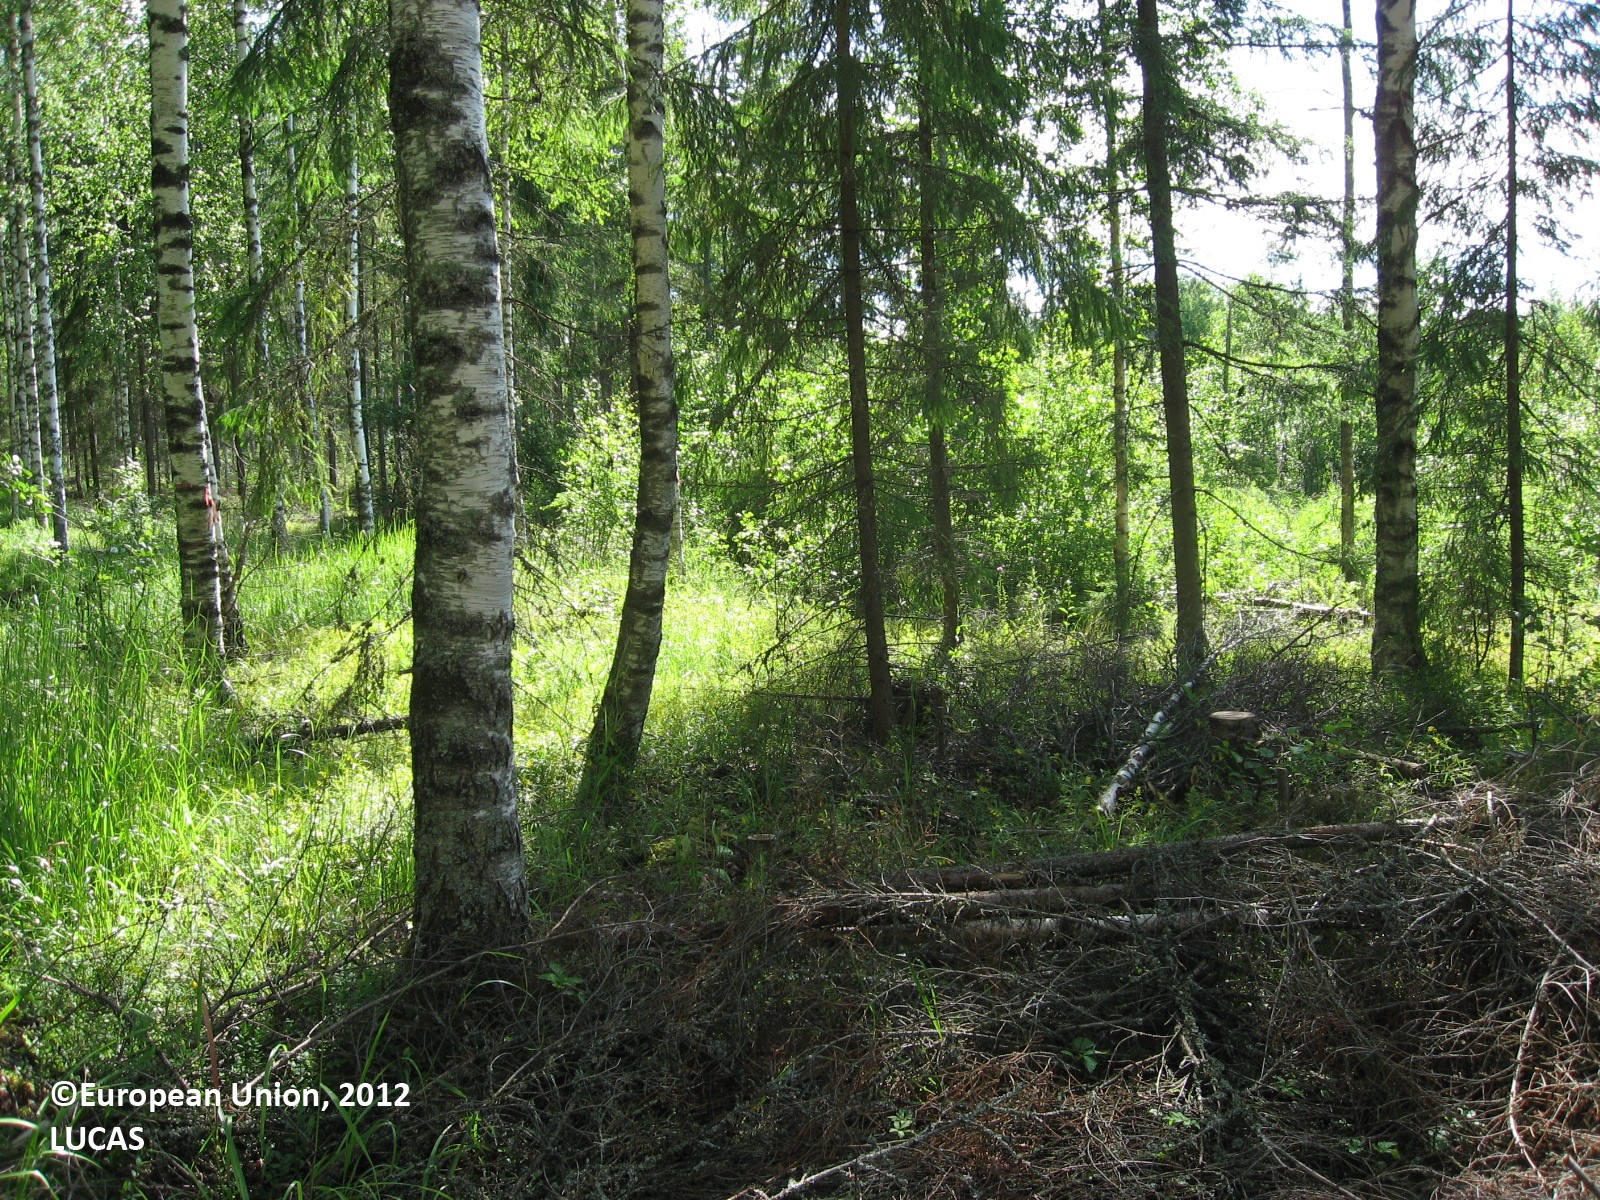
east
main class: Woodland
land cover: Other mixed woodland
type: boreal forest
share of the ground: 25 - 50 %
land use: Forestry
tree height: > 5 m
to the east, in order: Other mixed woodland; Ditches and canals; Broadleaved woodland; Ditches and canals; Broadleaved woodland; Ditches and canals; Other mixed woodland; Ditches and canals; Broadleaved woodland; Ditches and canals; Broadleaved woodland
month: June
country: FI
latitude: 60.6835
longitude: 26.4293
